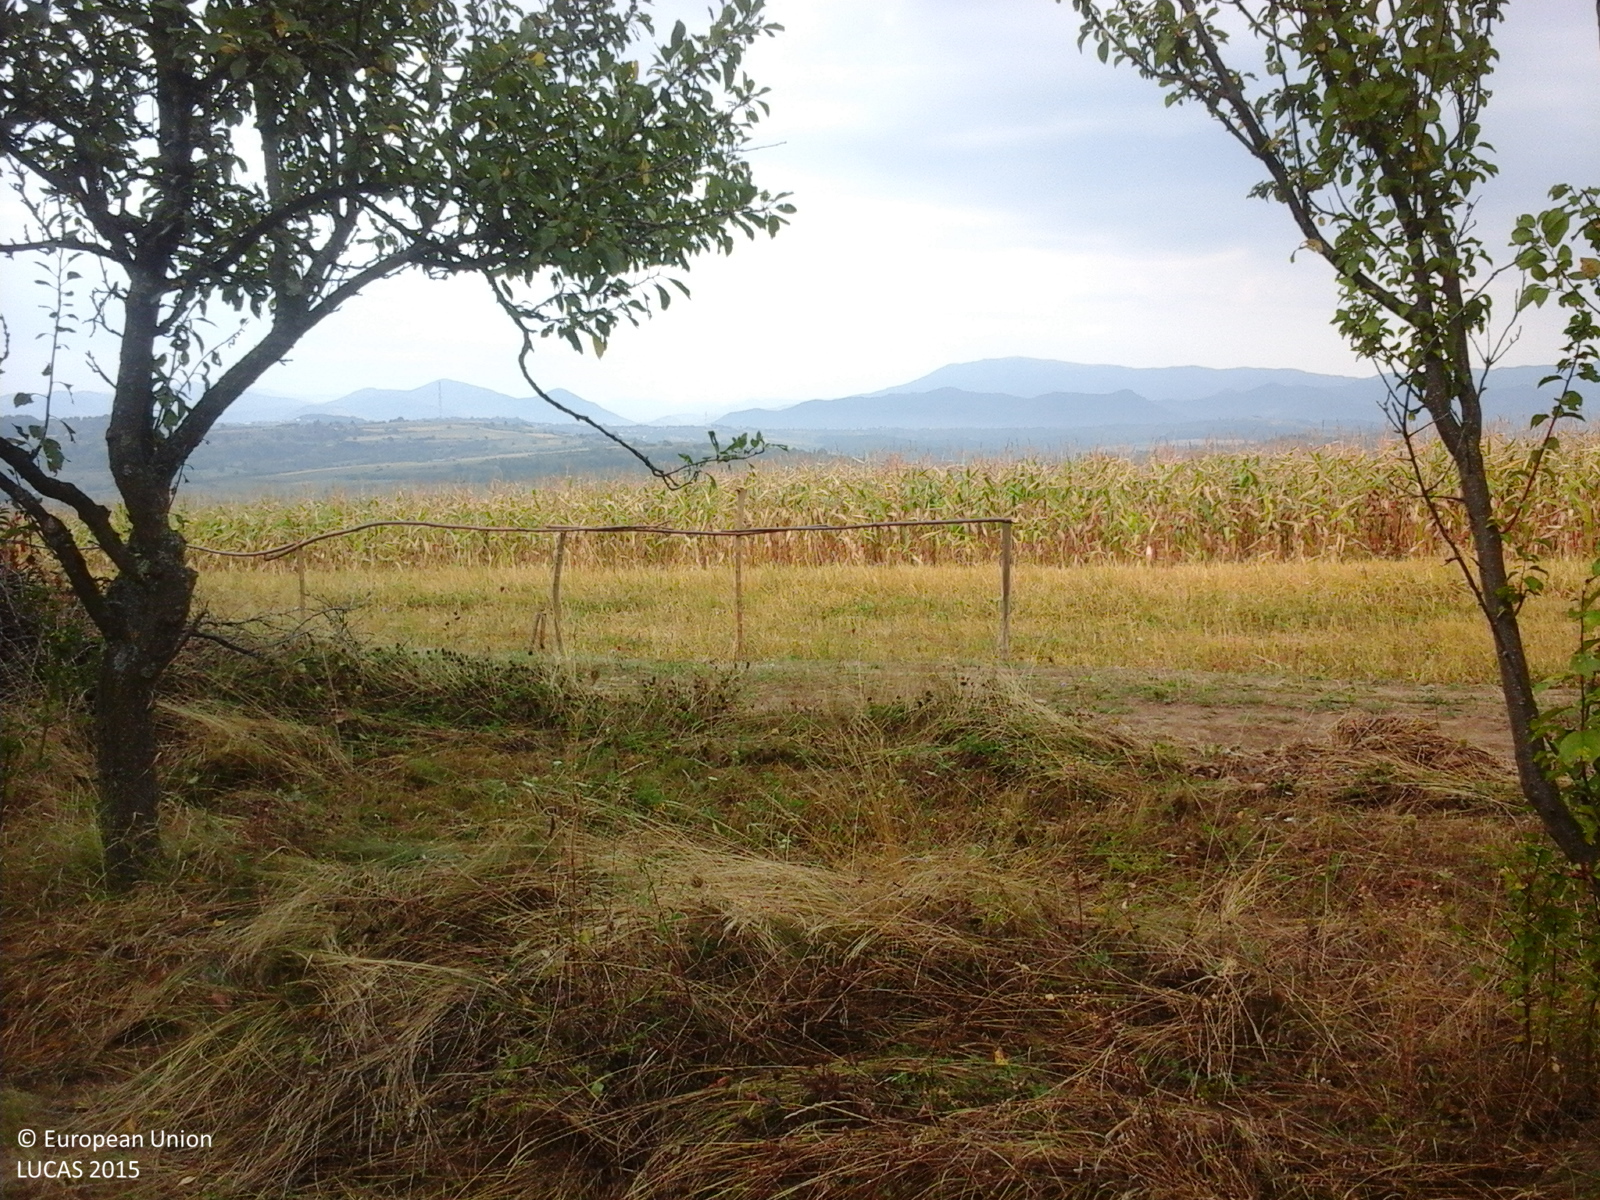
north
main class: Cropland
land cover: Apple fruit
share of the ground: 50 - 75 %
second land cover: Grassland without tree/shrub cover
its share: > 75 %
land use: Agriculture (excluding fallow land and kitchen gardens)
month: September
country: RO
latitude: 47.5737
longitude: 23.6228
